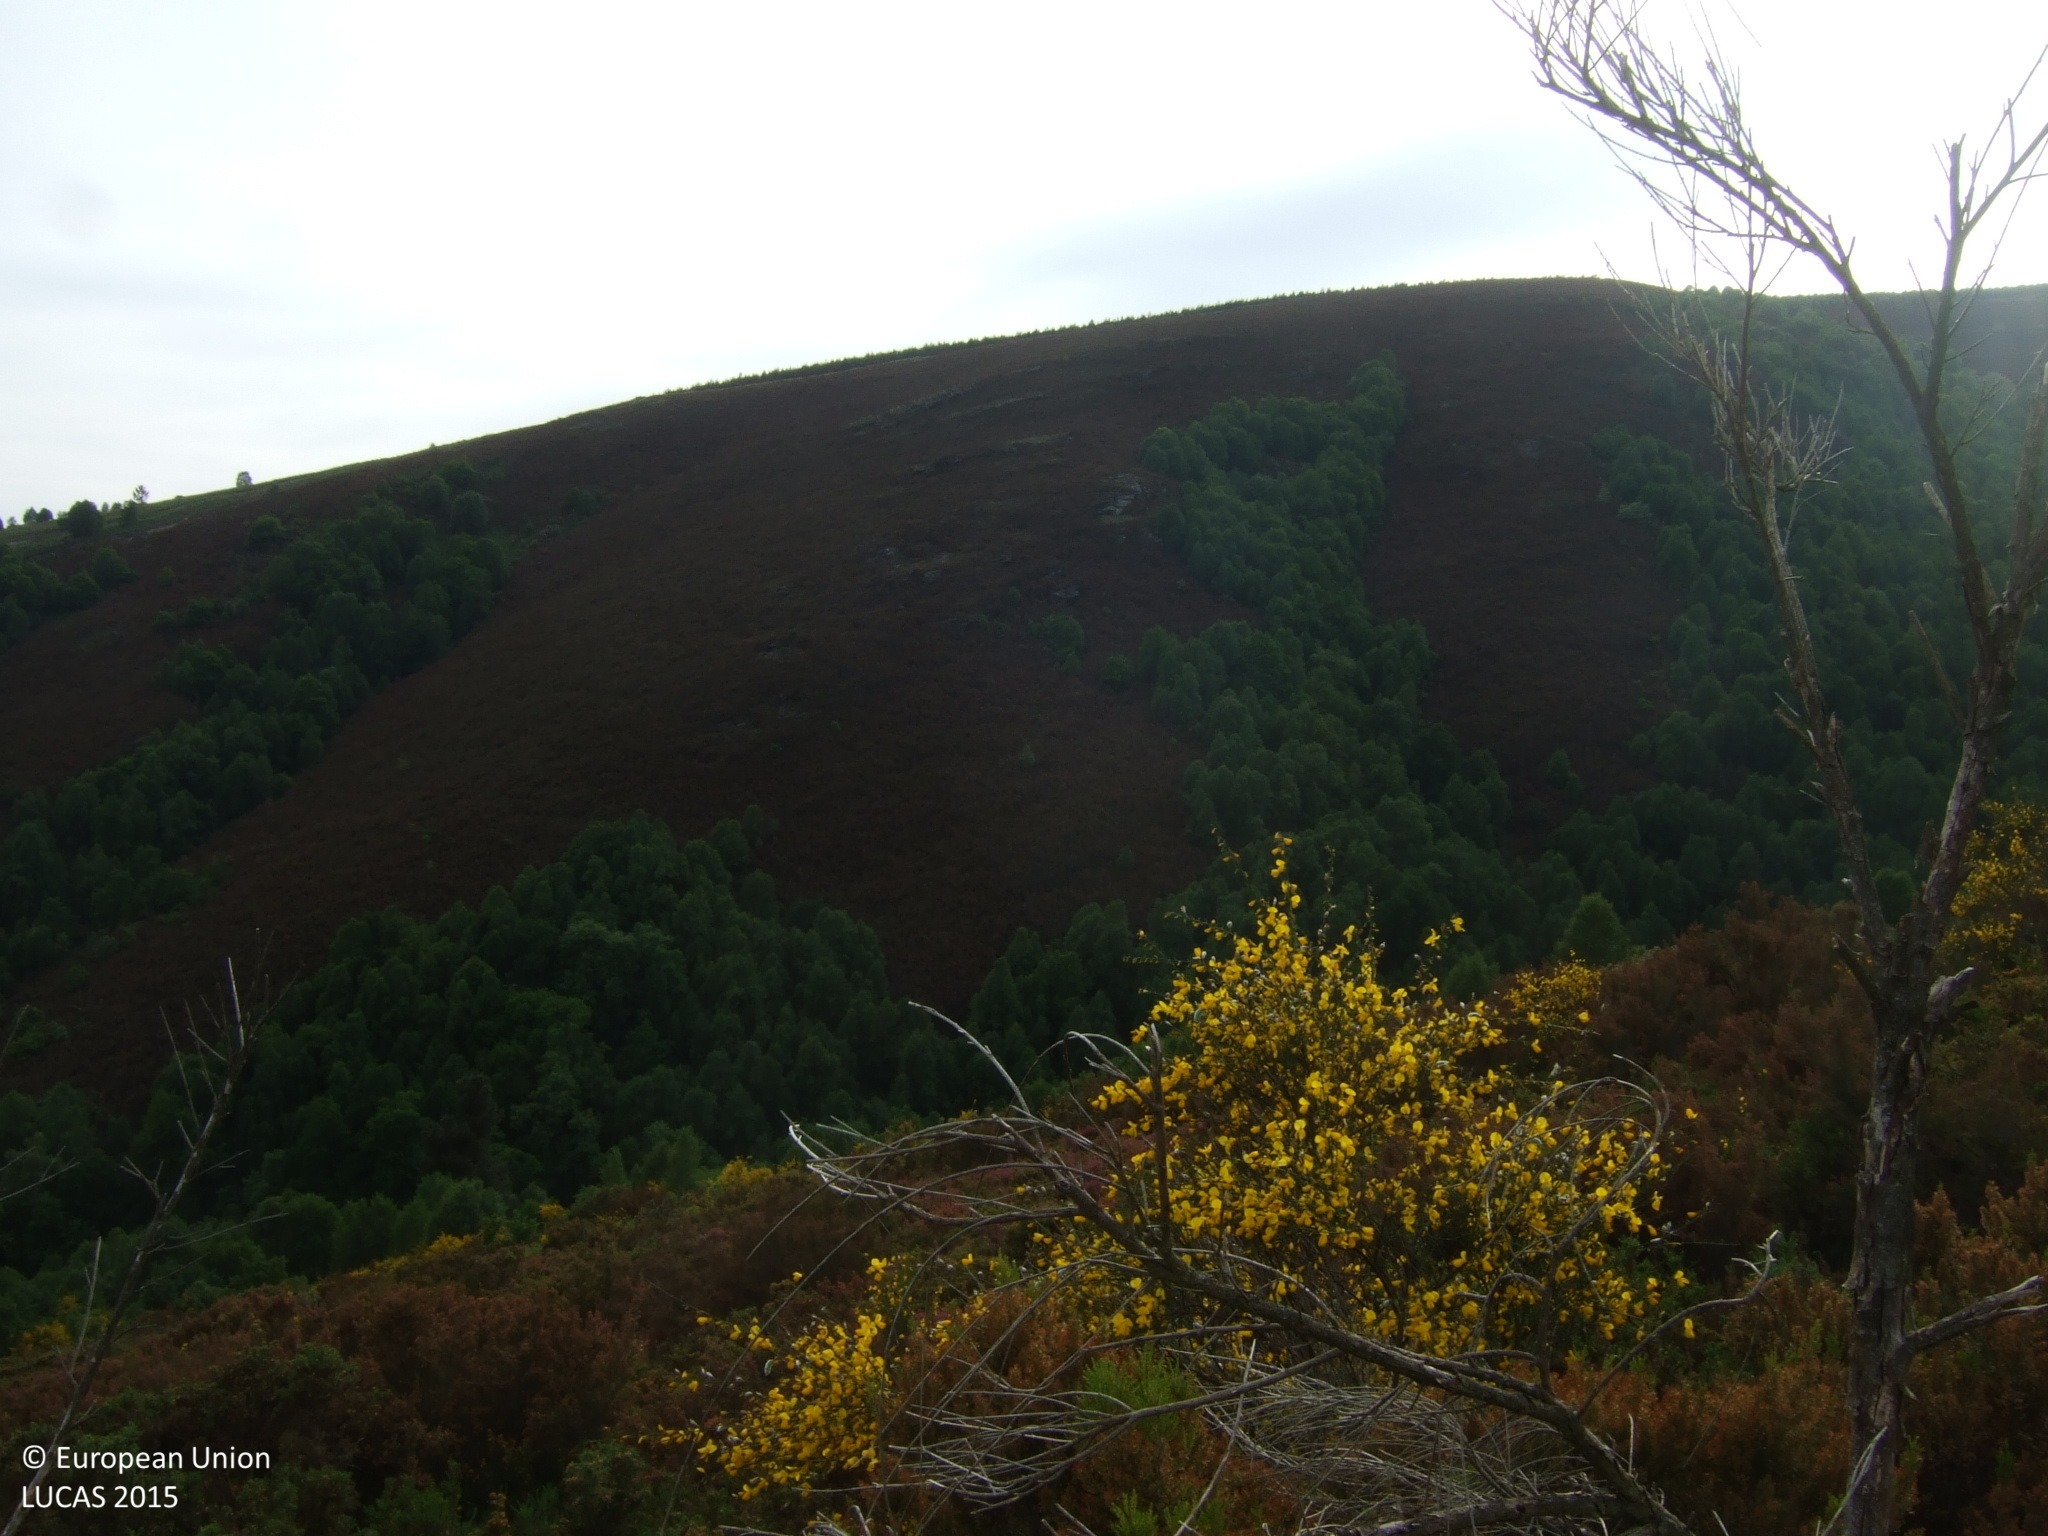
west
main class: Shrubland
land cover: Shrubland without tree cover
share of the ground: > 75 %
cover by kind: shrubs 100 %
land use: Semi-natural and natural areas not in use
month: June
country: ES
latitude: 42.7796
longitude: -7.2643
